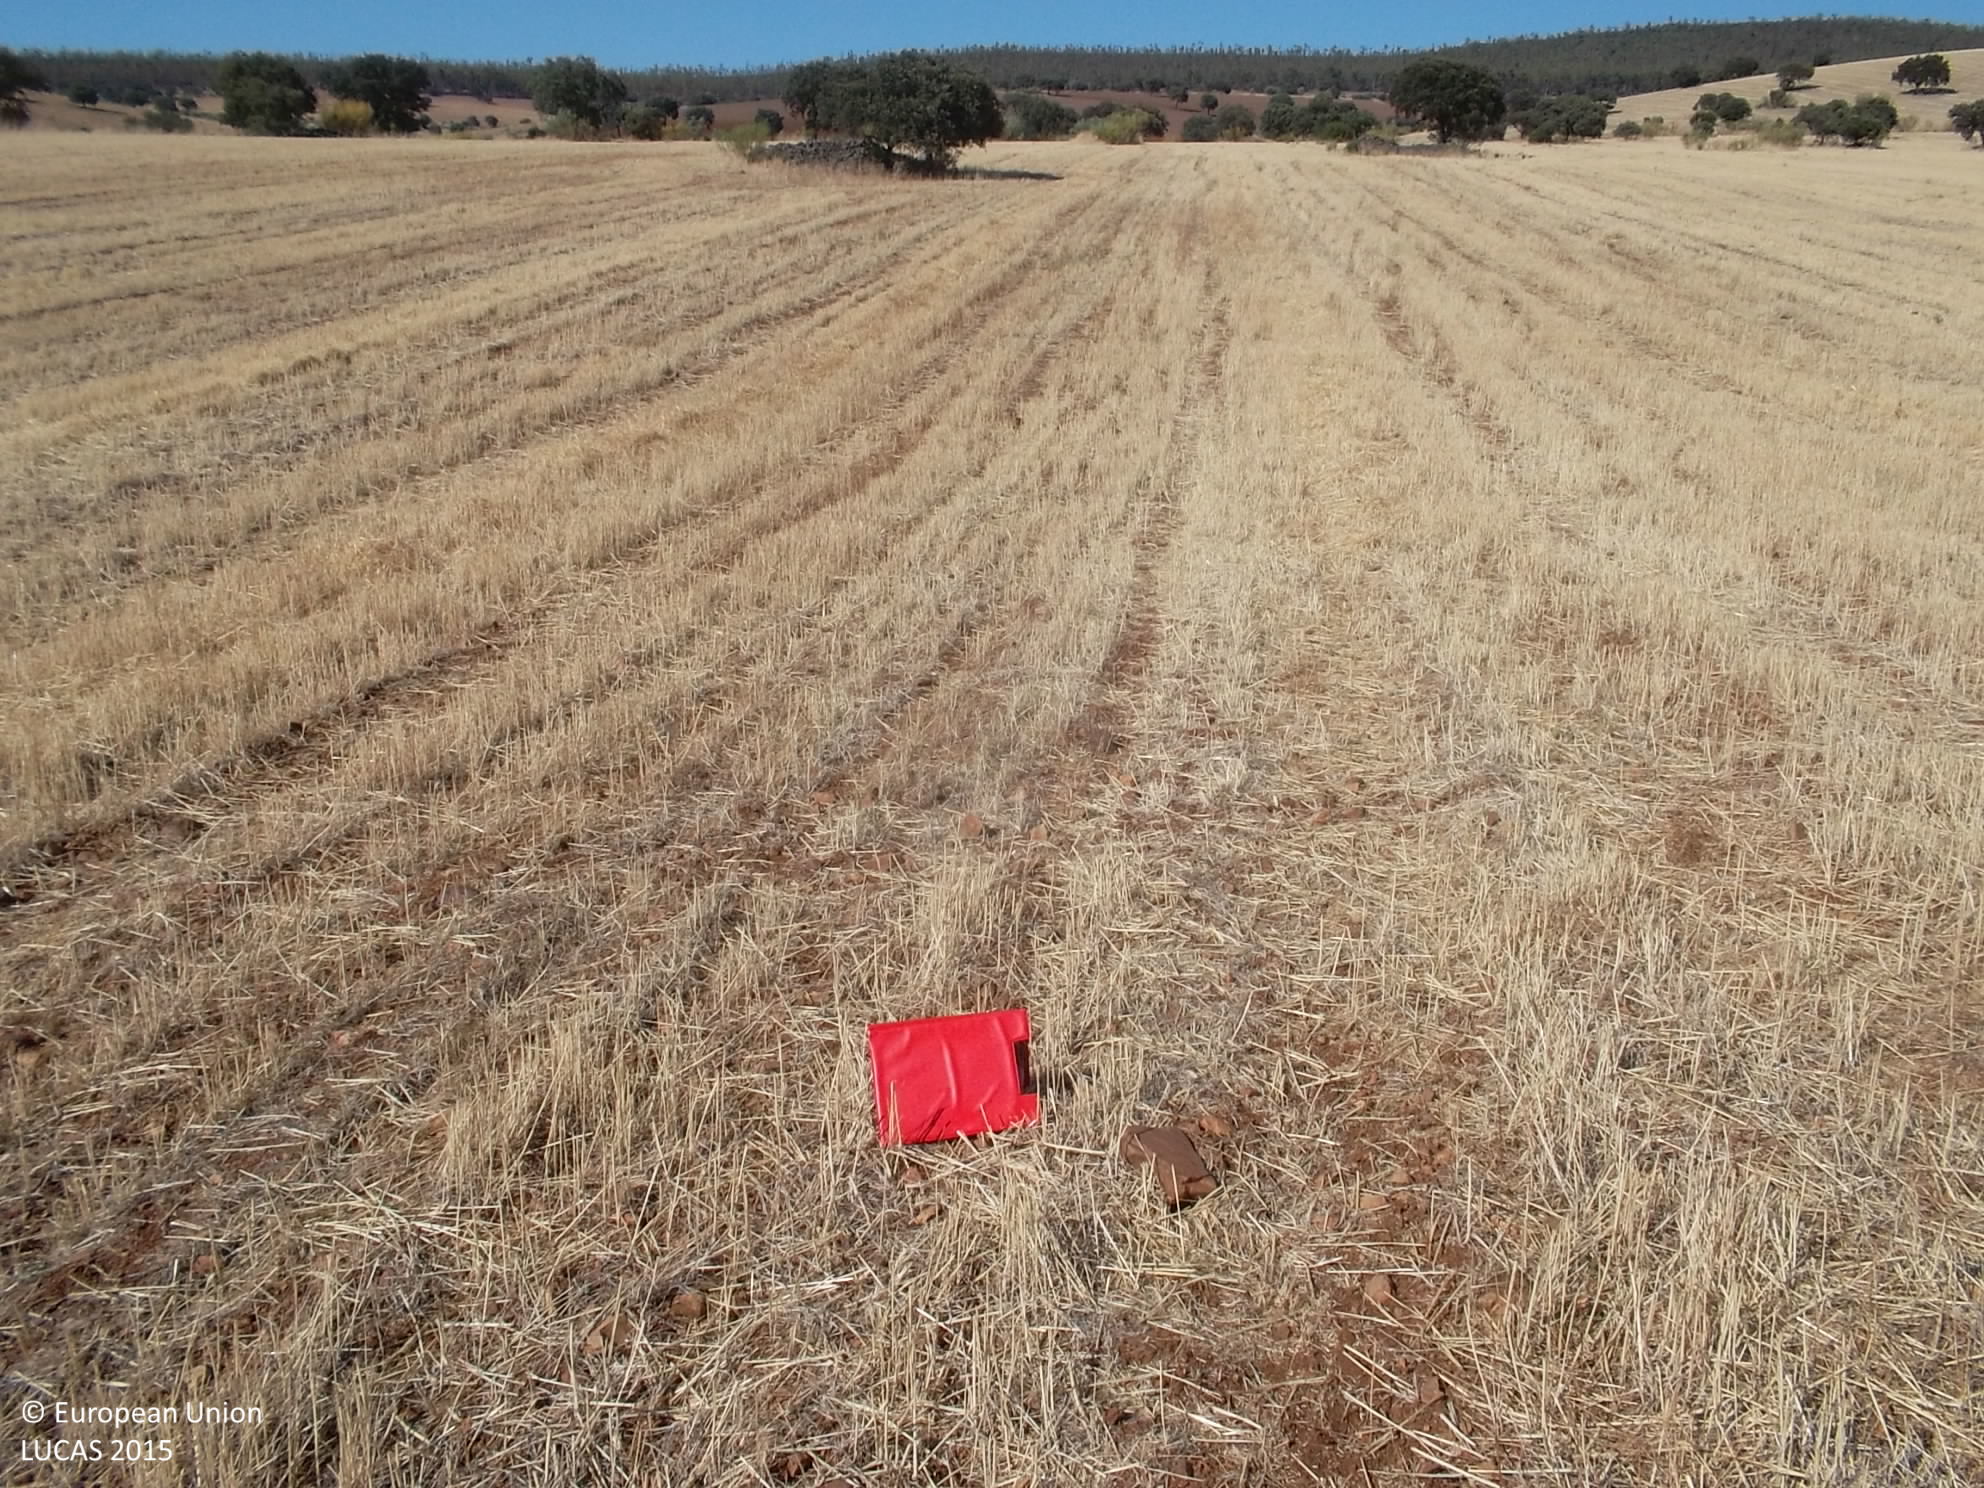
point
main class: Cropland
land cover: Durum wheat
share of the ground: < 10 %
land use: Agriculture (excluding fallow land and kitchen gardens)
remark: Harvested field
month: July
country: ES
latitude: 38.5766
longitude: -5.7785
